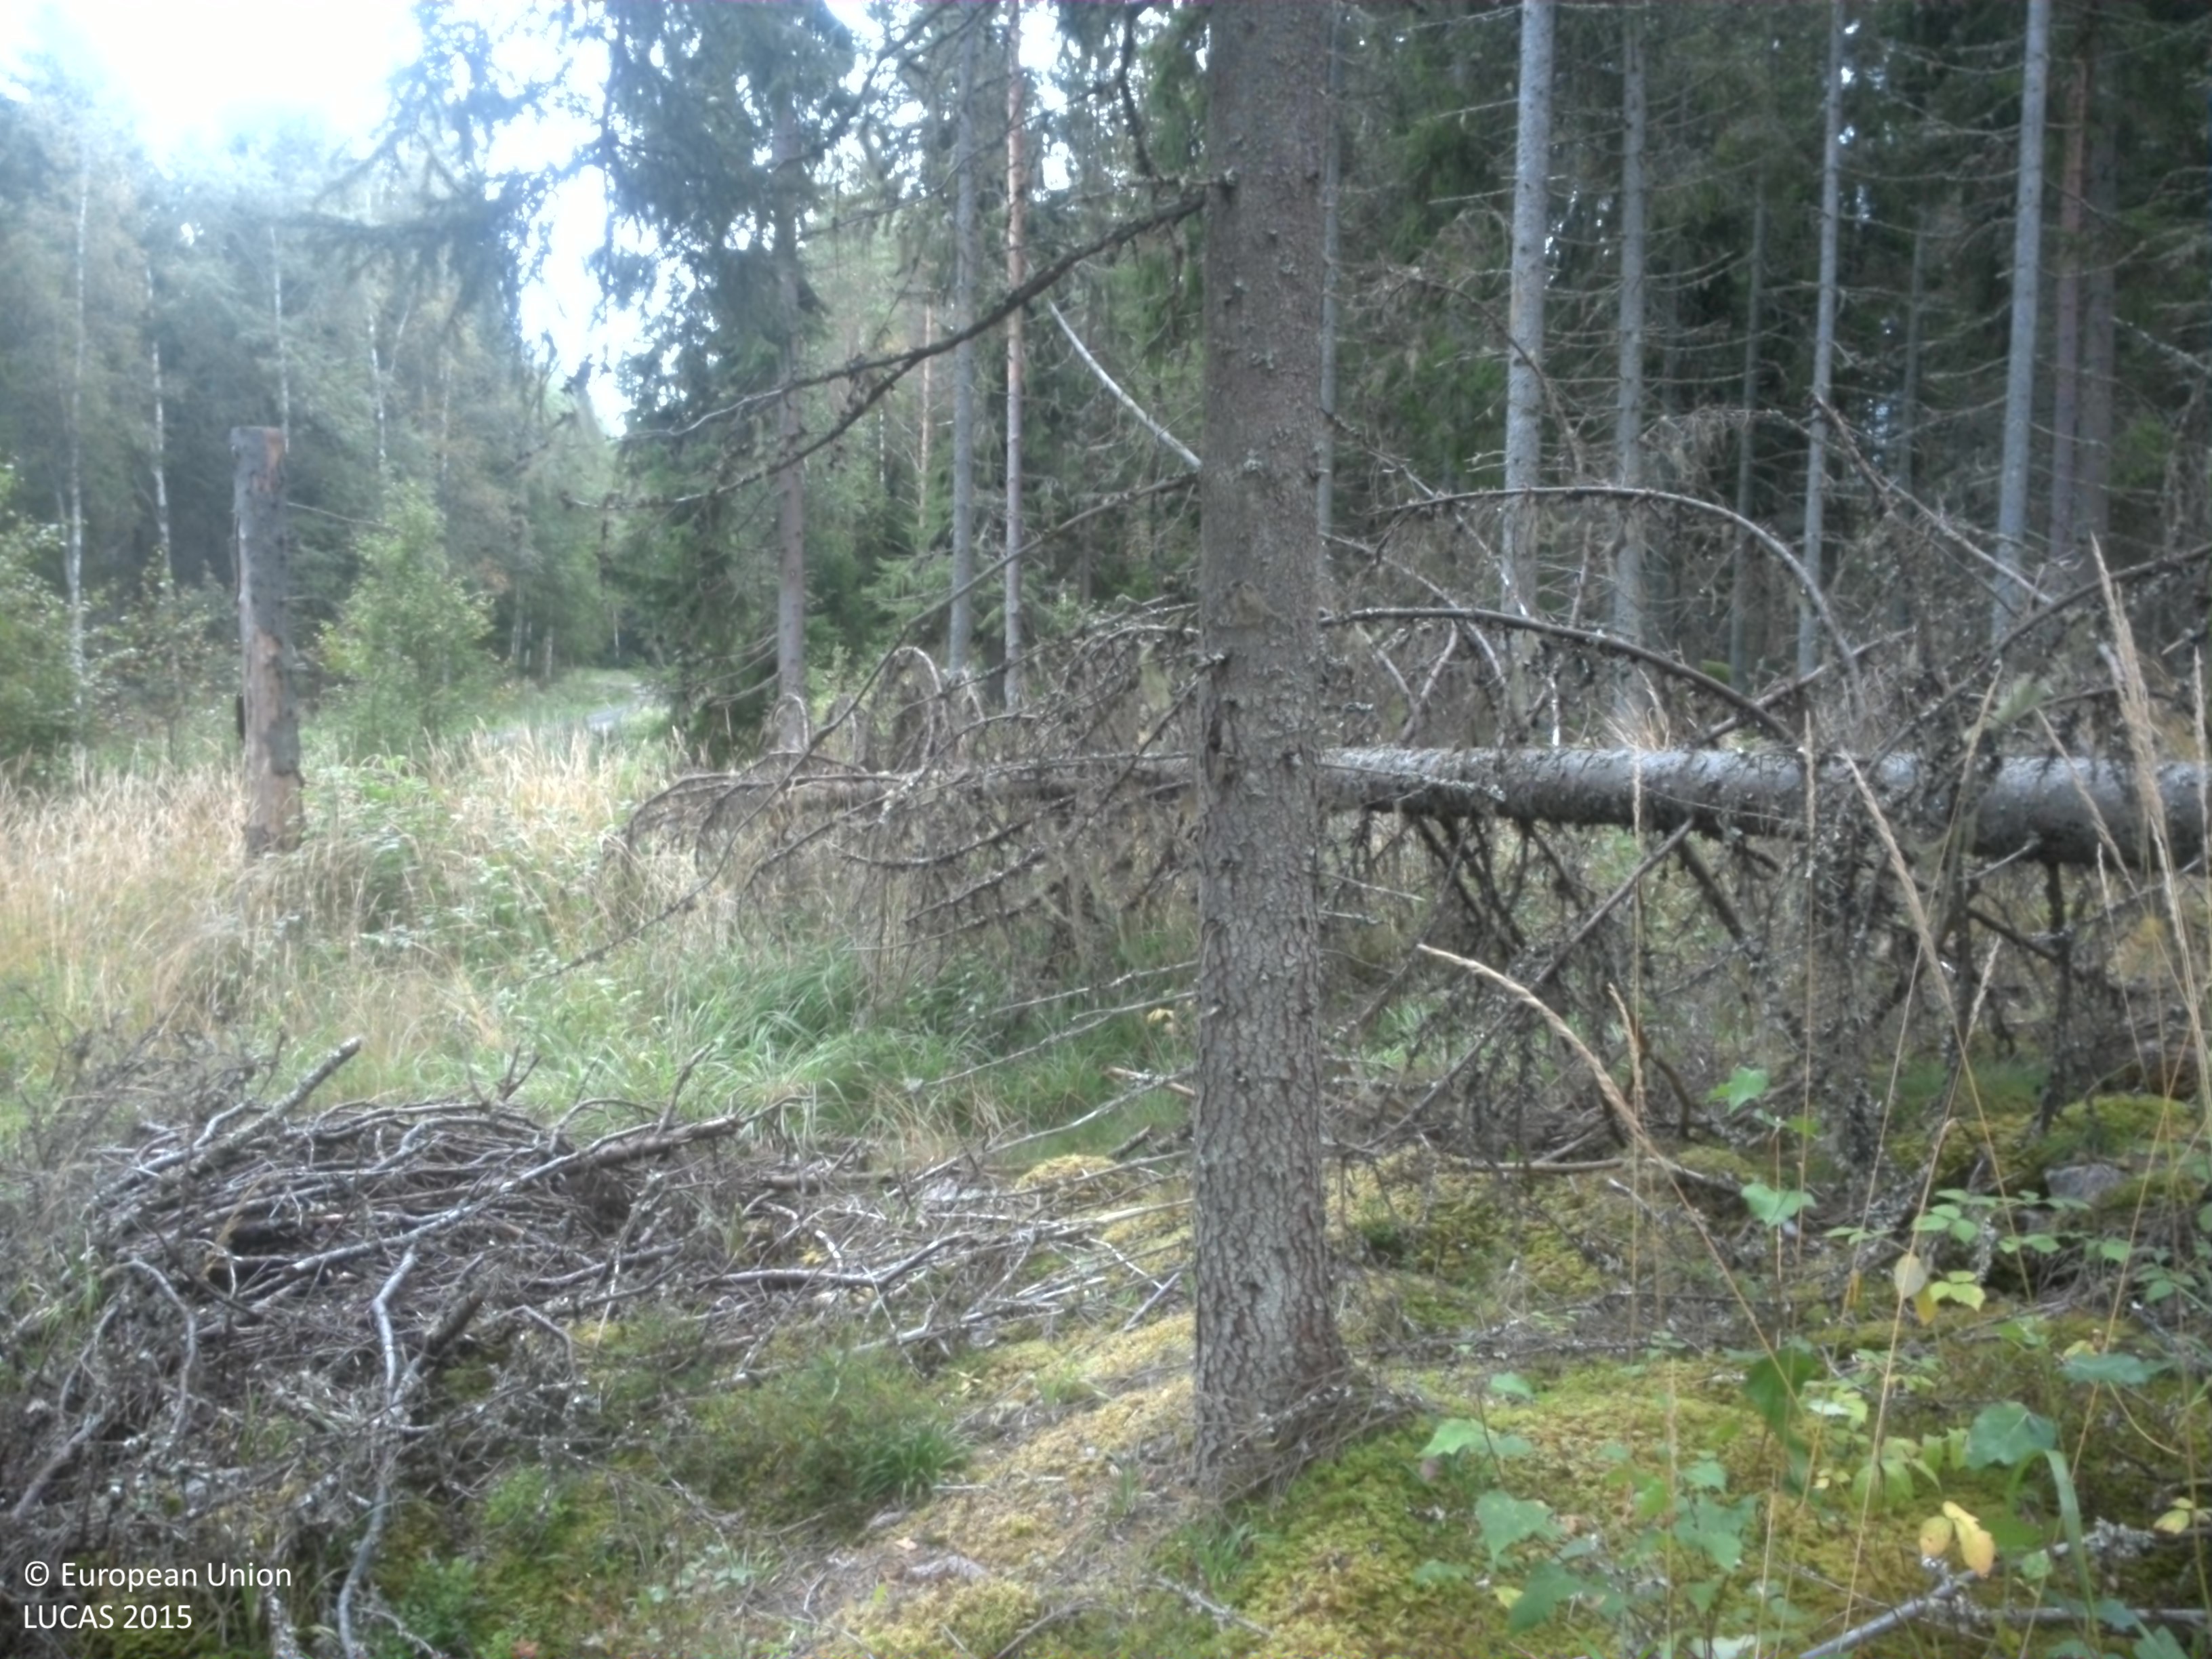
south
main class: Woodland
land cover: Spruce dominated coniferous woodland
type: boreal forest
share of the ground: 50 - 75 %
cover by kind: coniferous forest trees 60 %, lichens and mosses 25 %, herbaceous plants 10 %, shrubs 5 %
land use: Forestry
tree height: > 5 m
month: September
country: SE
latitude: 59.6165
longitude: 15.6452
